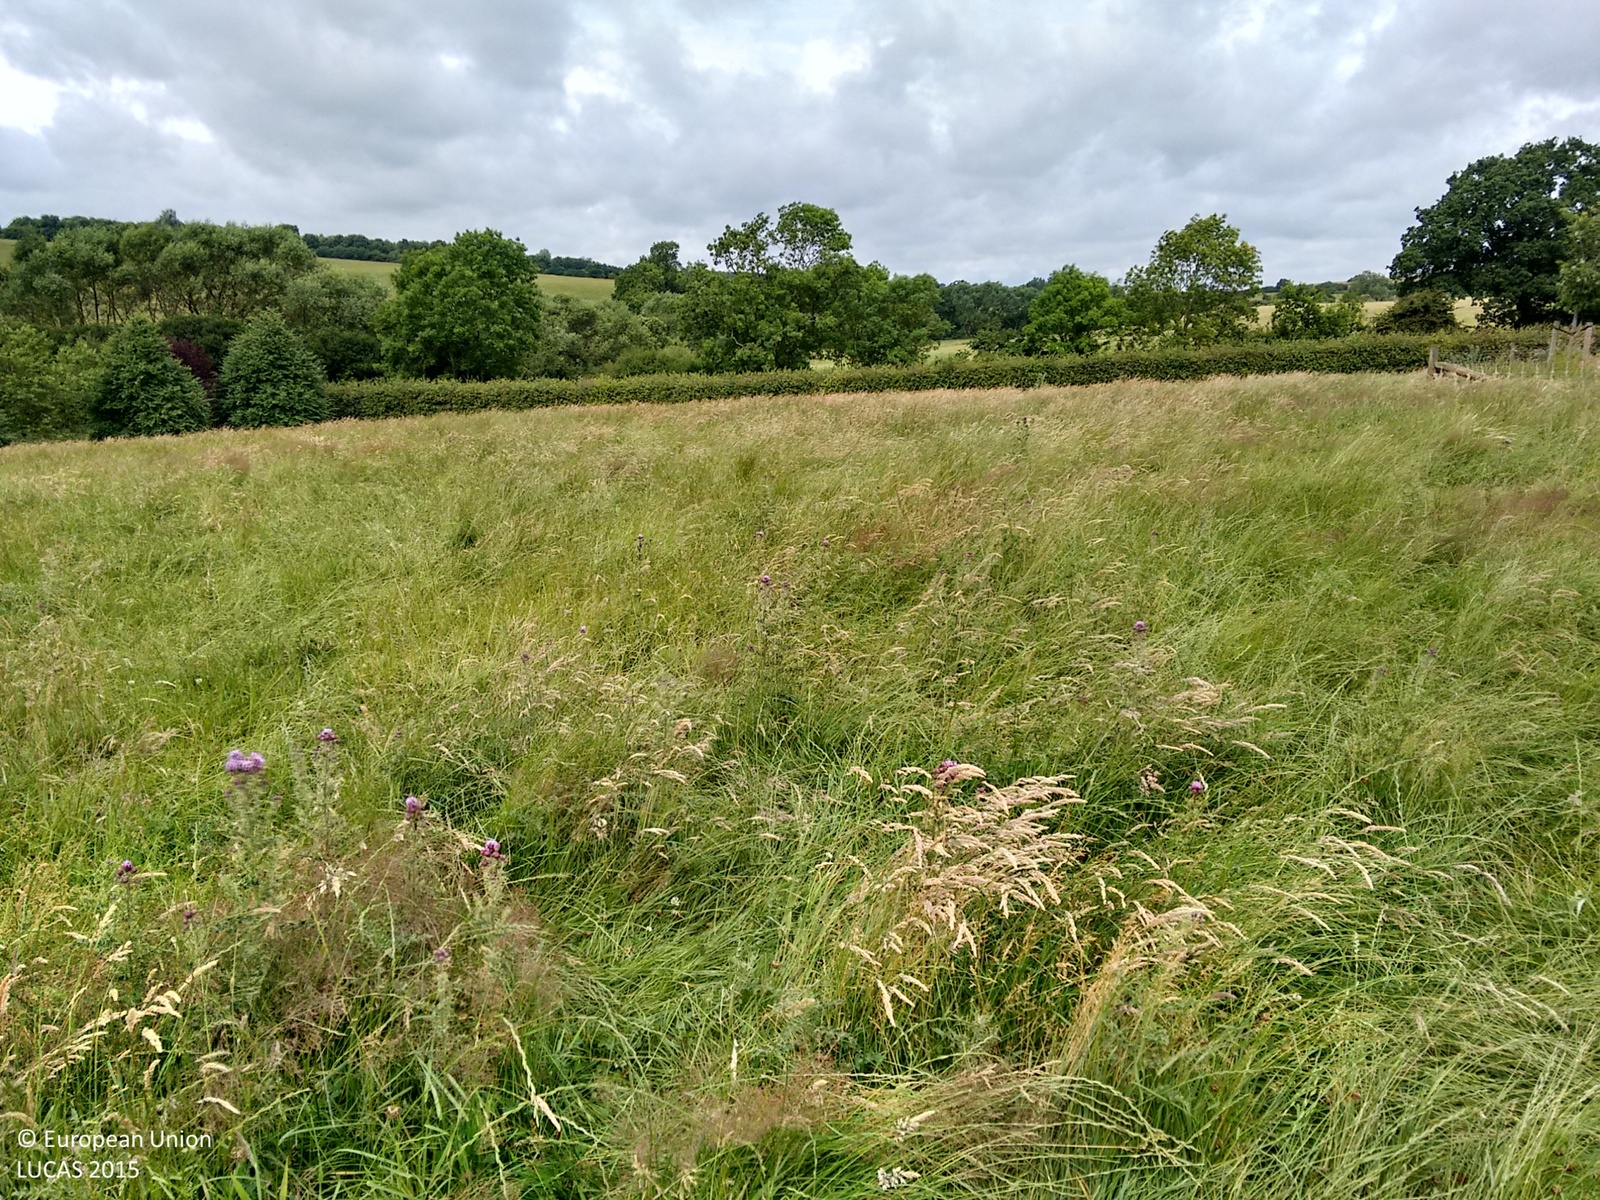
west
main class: Grassland
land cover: Grassland without tree/shrub cover
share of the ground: > 75 %
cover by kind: herbaceous plants 100 %
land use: Agriculture (excluding fallow land and kitchen gardens)
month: July
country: GB
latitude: 52.6287
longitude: -0.7821
